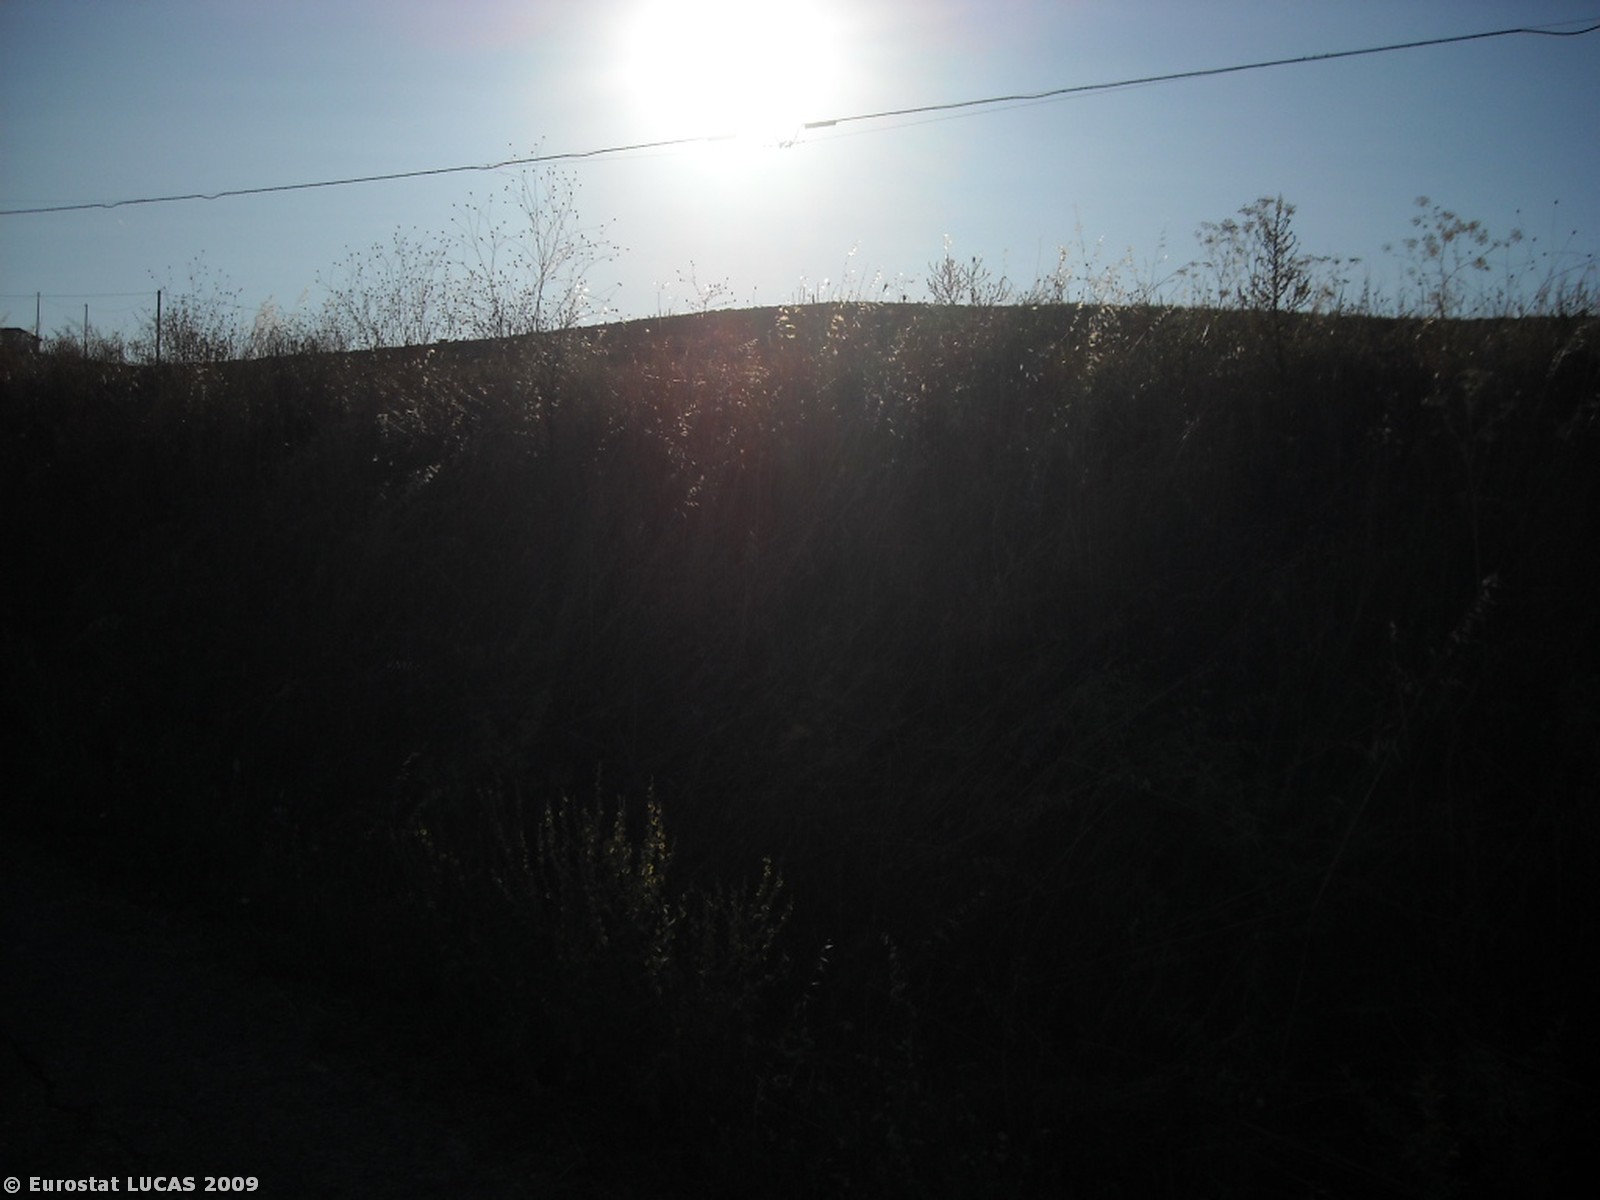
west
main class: Cropland
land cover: Durum wheat
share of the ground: < 10 %
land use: Agriculture (excluding fallow land and kitchen gardens)
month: July
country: IT
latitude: 40.7353
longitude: 16.3126
